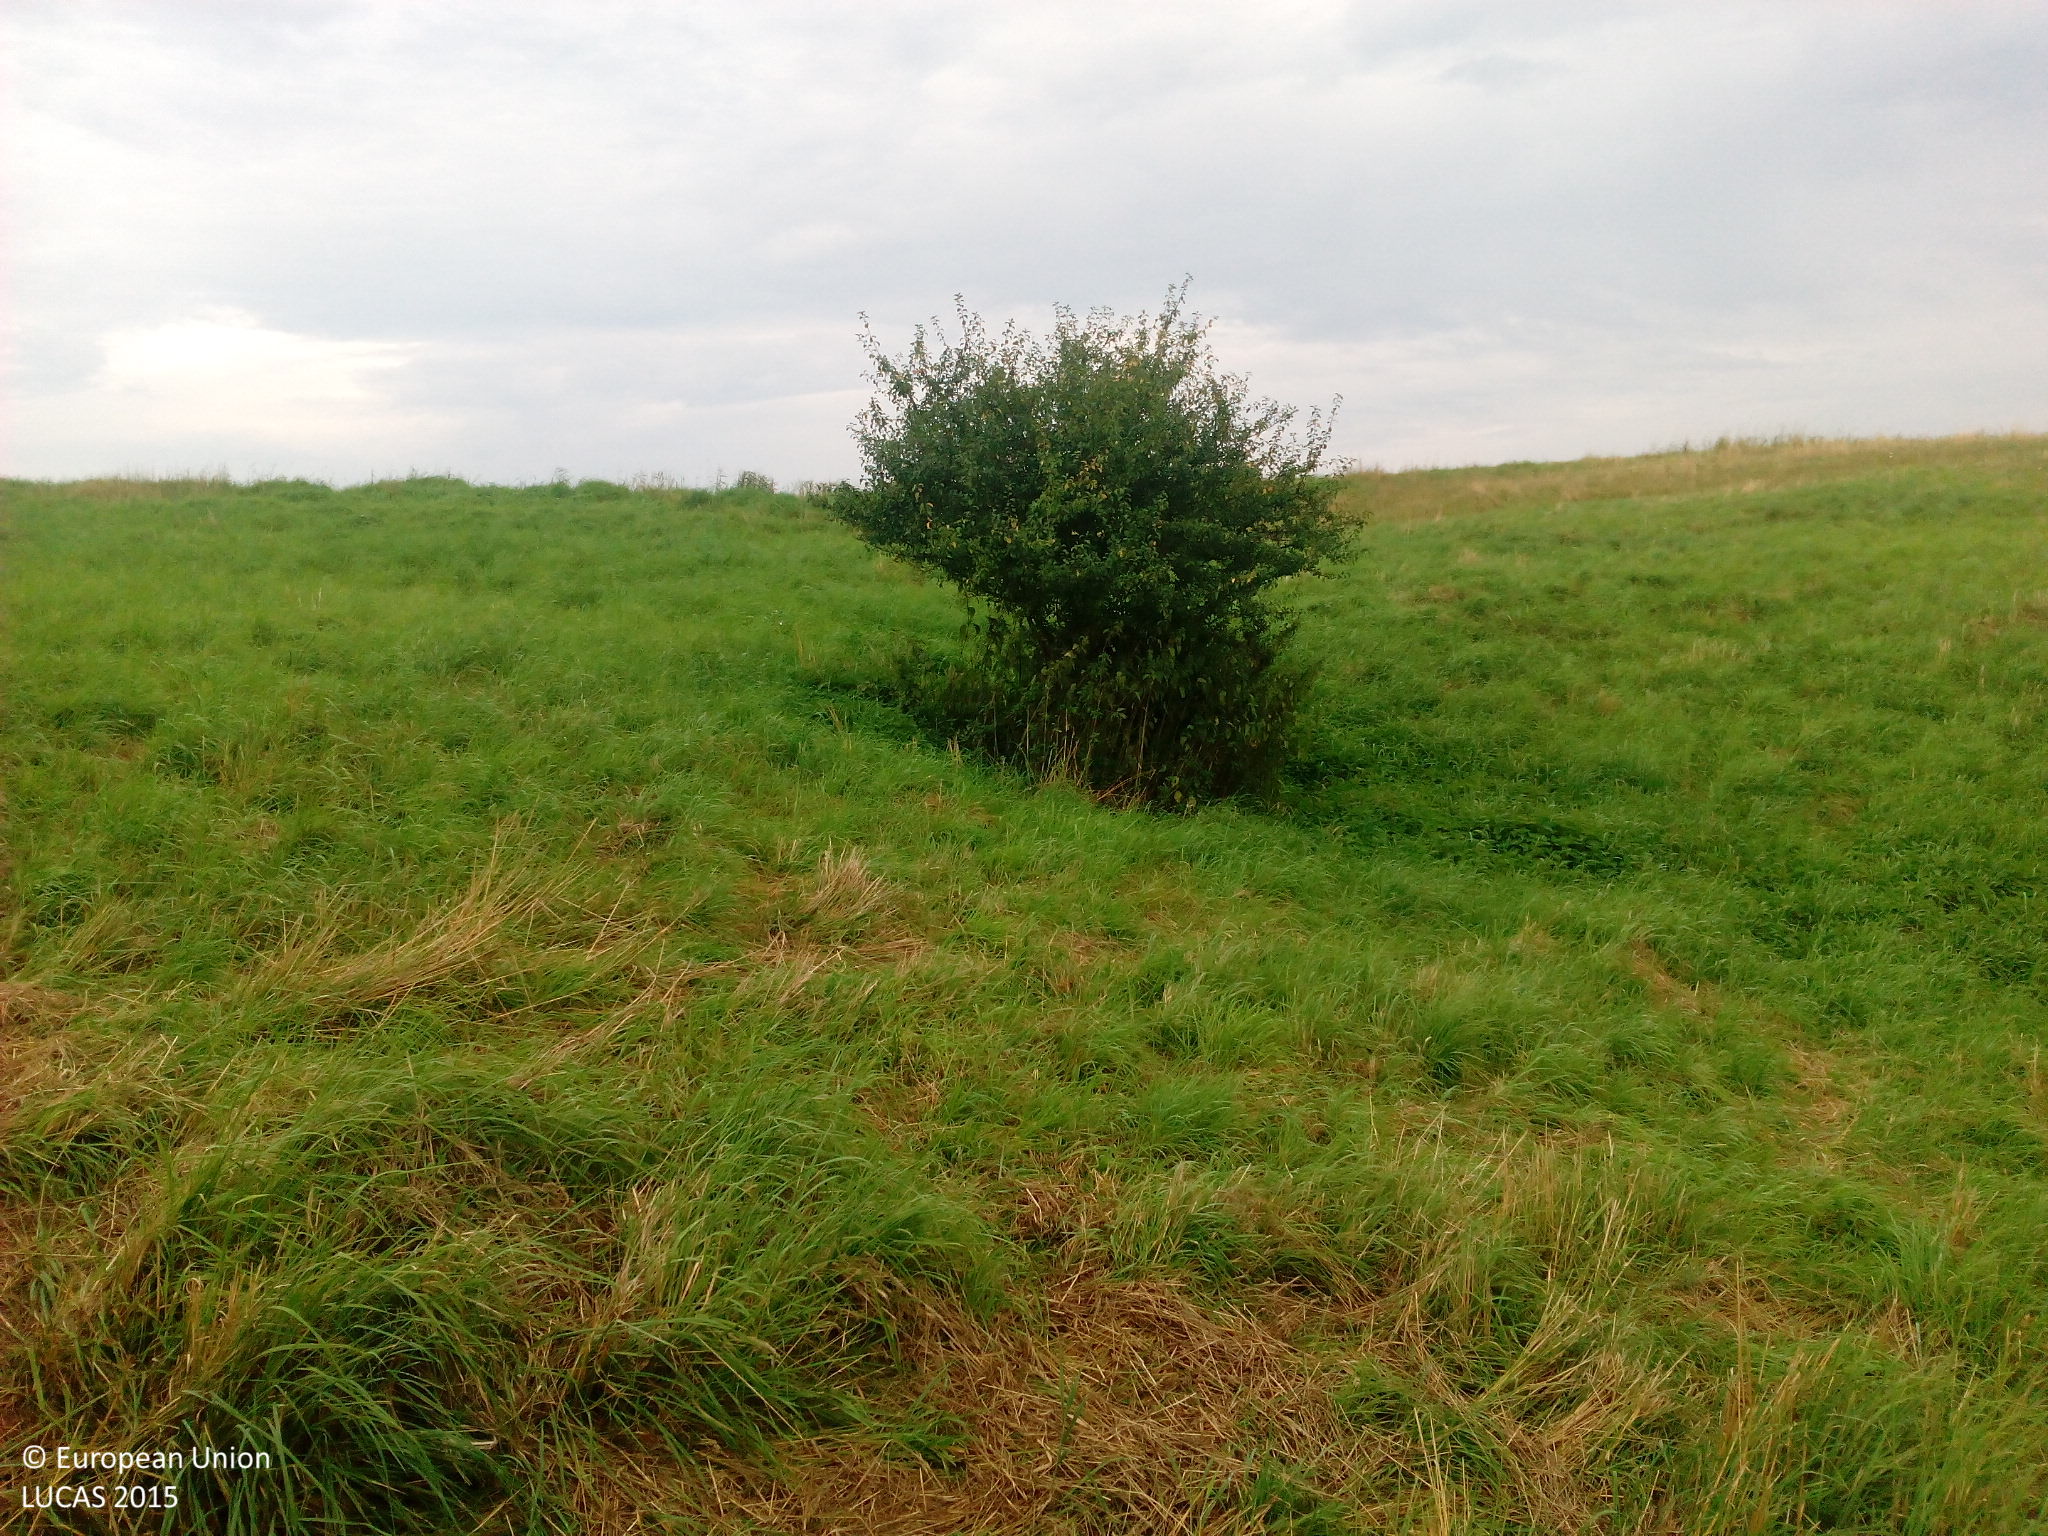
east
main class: Grassland
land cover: Grassland with sparse tree/shrub cover
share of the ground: > 75 %
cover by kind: herbaceous plants 95 %, broadleaved forest trees 5 %
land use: Agriculture (excluding fallow land and kitchen gardens)
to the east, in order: Grassland with sparse tree/shrub cover; Common wheat
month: August
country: DE
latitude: 53.6290
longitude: 13.2204
